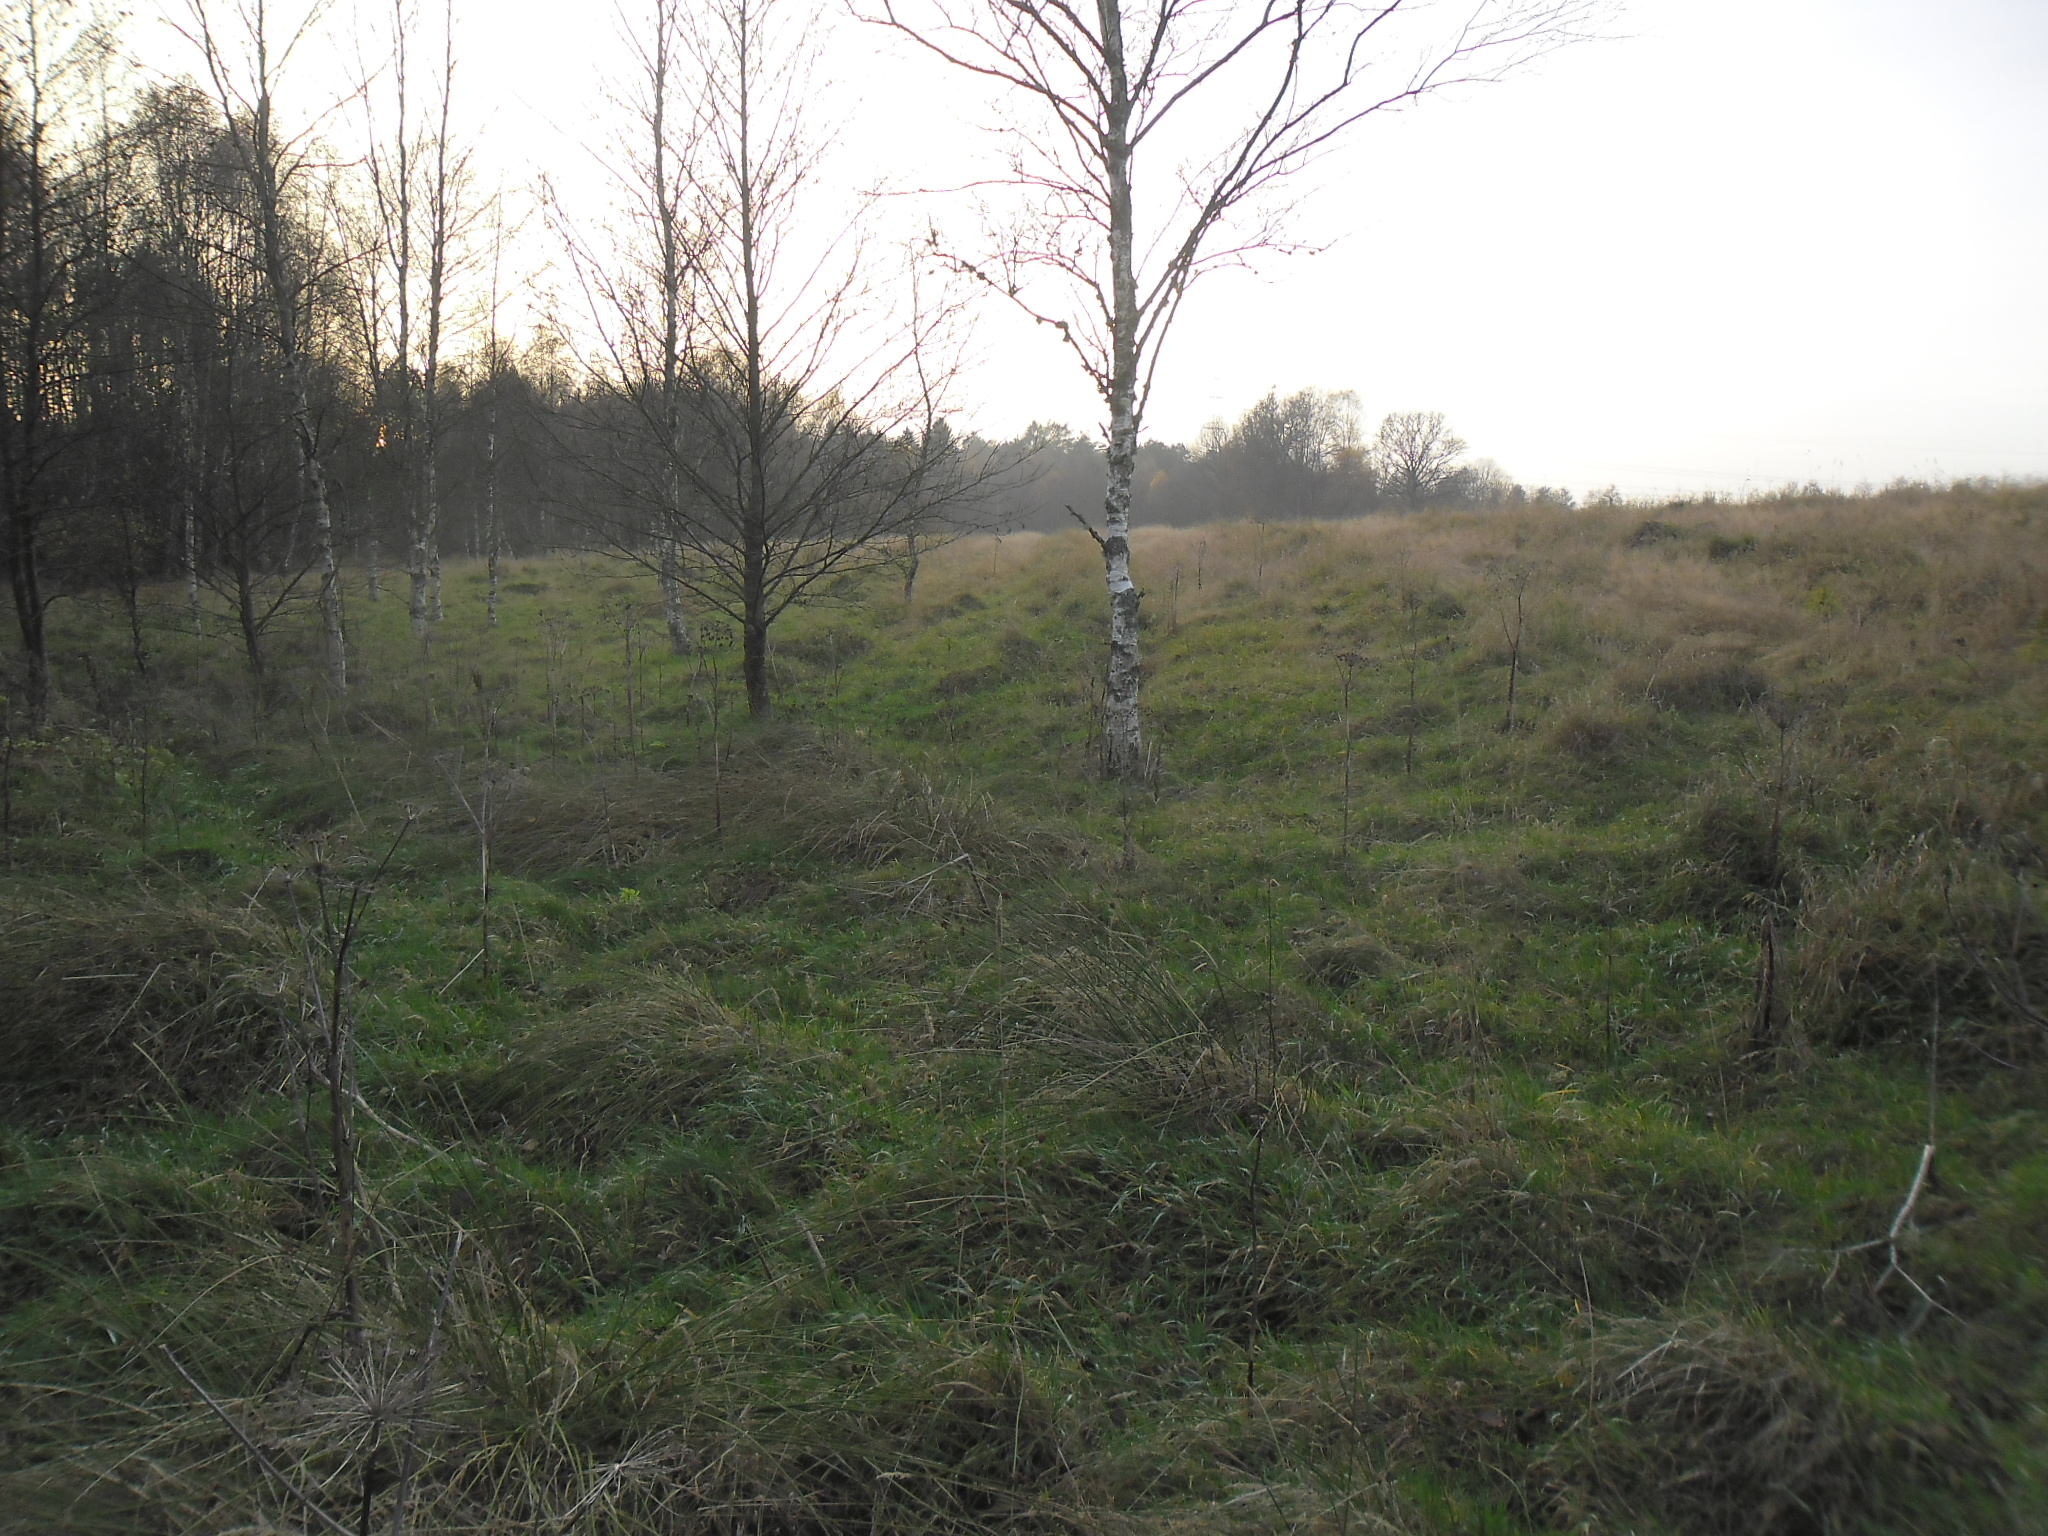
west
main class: Grassland
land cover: Grassland without tree/shrub cover
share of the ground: > 75 %
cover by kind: herbaceous plants 100 %
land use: Semi-natural and natural areas not in use
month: November
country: SE
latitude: 56.2580
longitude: 13.1128
